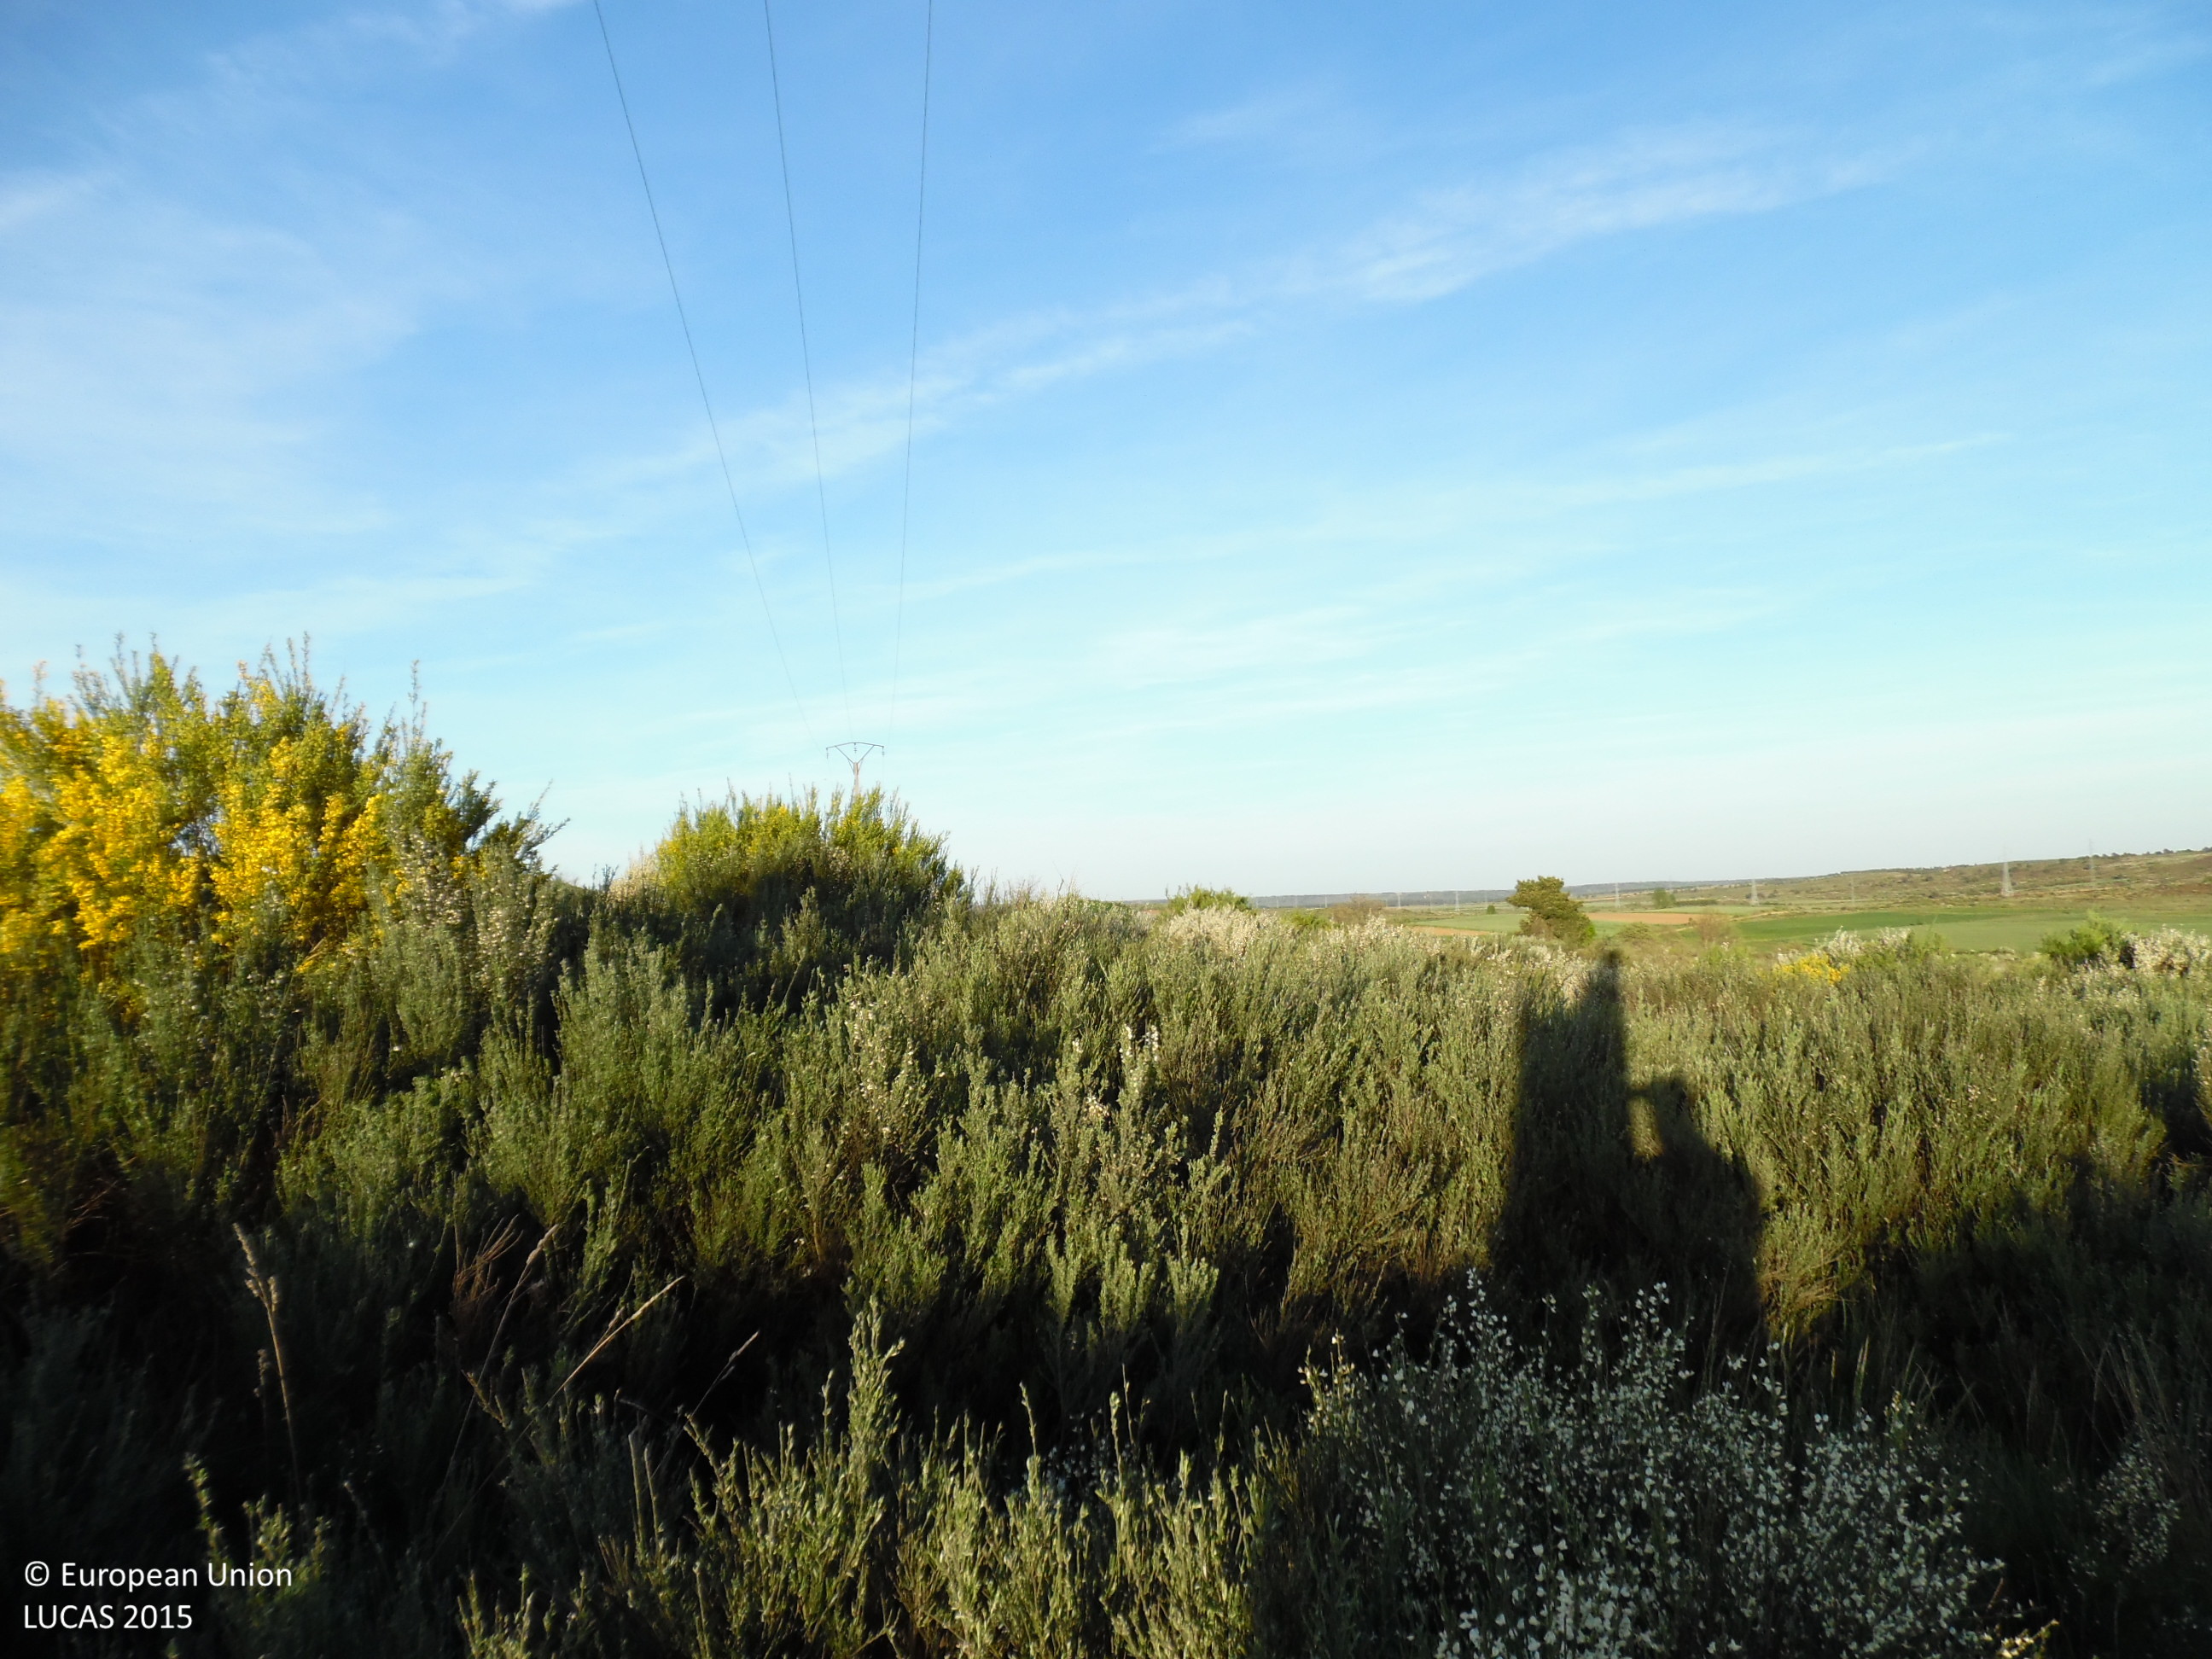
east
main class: Shrubland
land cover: Shrubland without tree cover
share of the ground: > 75 %
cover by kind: shrubs 100 %
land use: Abandoned areas
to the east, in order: Shrubland without tree cover; Grassland without tree/shrub cover; Shrubland without tree cover; Grassland with sparse tree/shrub cover; Electric lines; Grassland with sparse tree/shrub cover; Grass margins; Barley
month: May
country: ES
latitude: 42.6350
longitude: -6.1463
